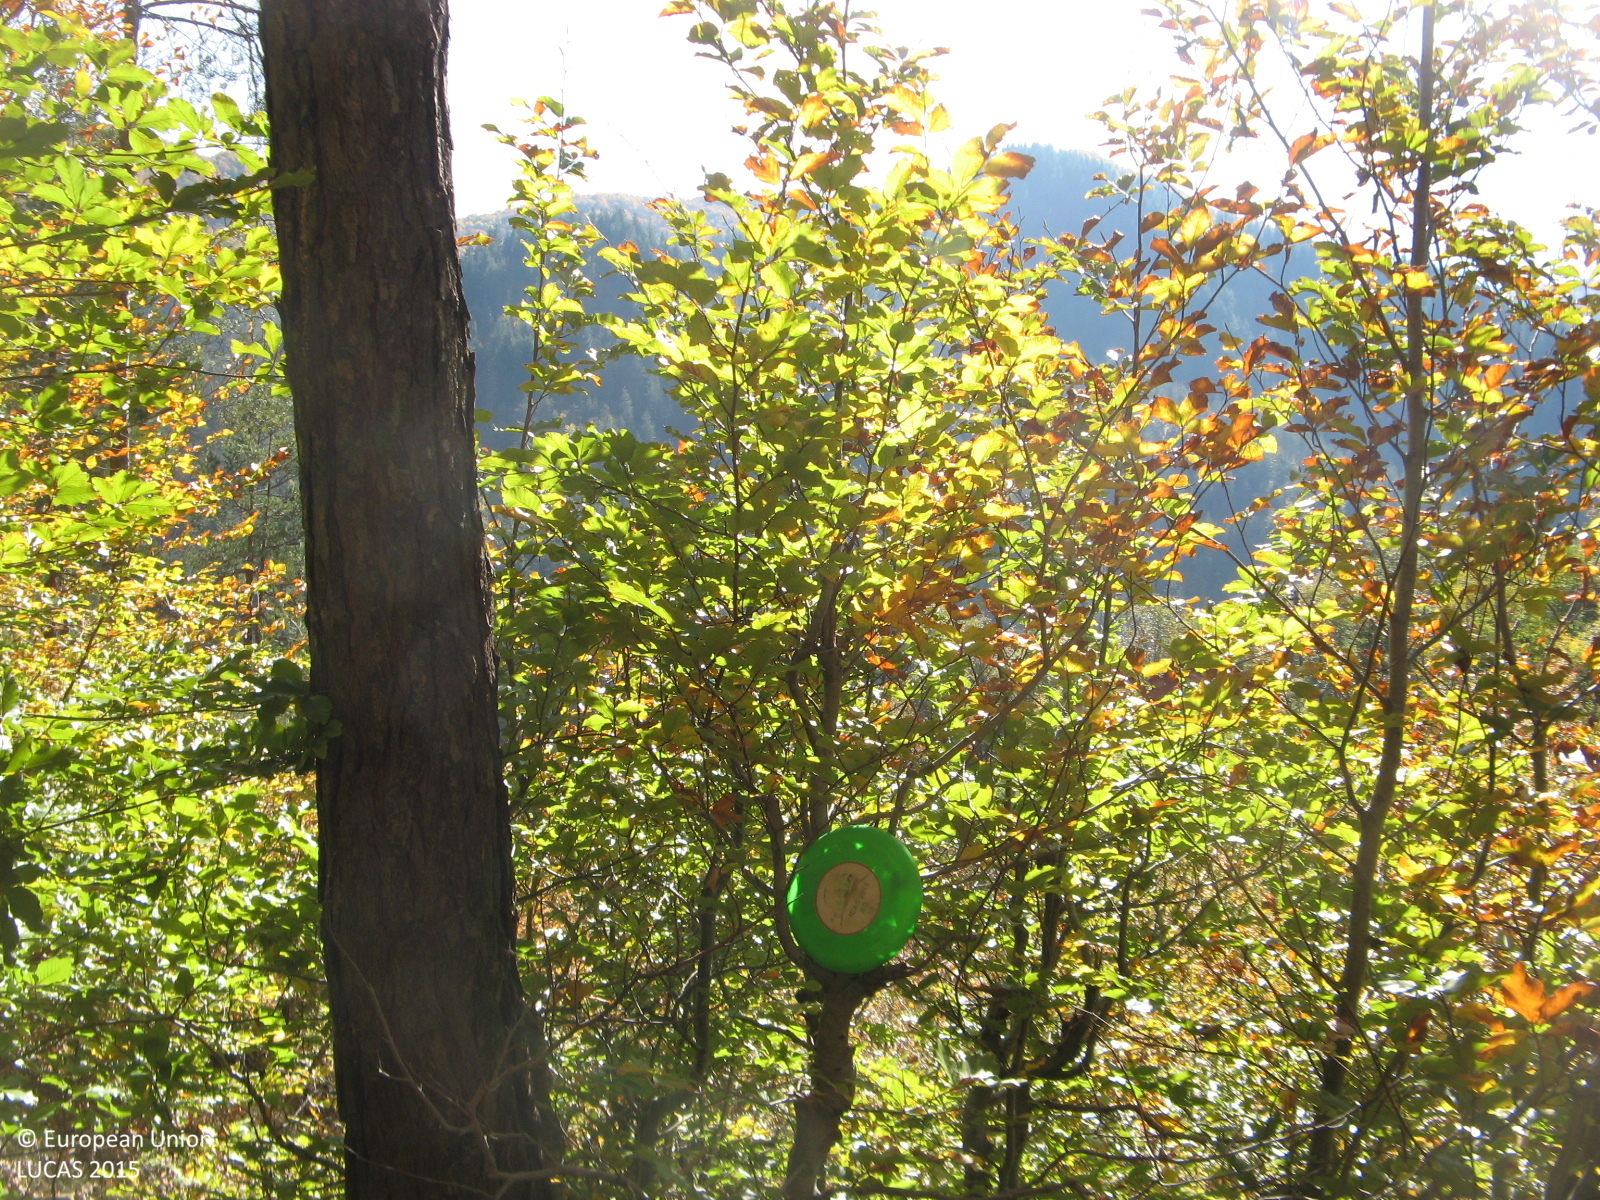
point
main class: Woodland
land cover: Pine dominated mixed woodland
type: hemiboreal forest and nemoral coniferous forest and mixed broadleaved-coniferous forest
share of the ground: > 75 %
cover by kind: coniferous forest trees 50 %, broadleaved forest trees 50 %
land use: Forestry
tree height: > 5 m
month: October
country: BG
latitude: 41.4812
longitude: 24.8353
